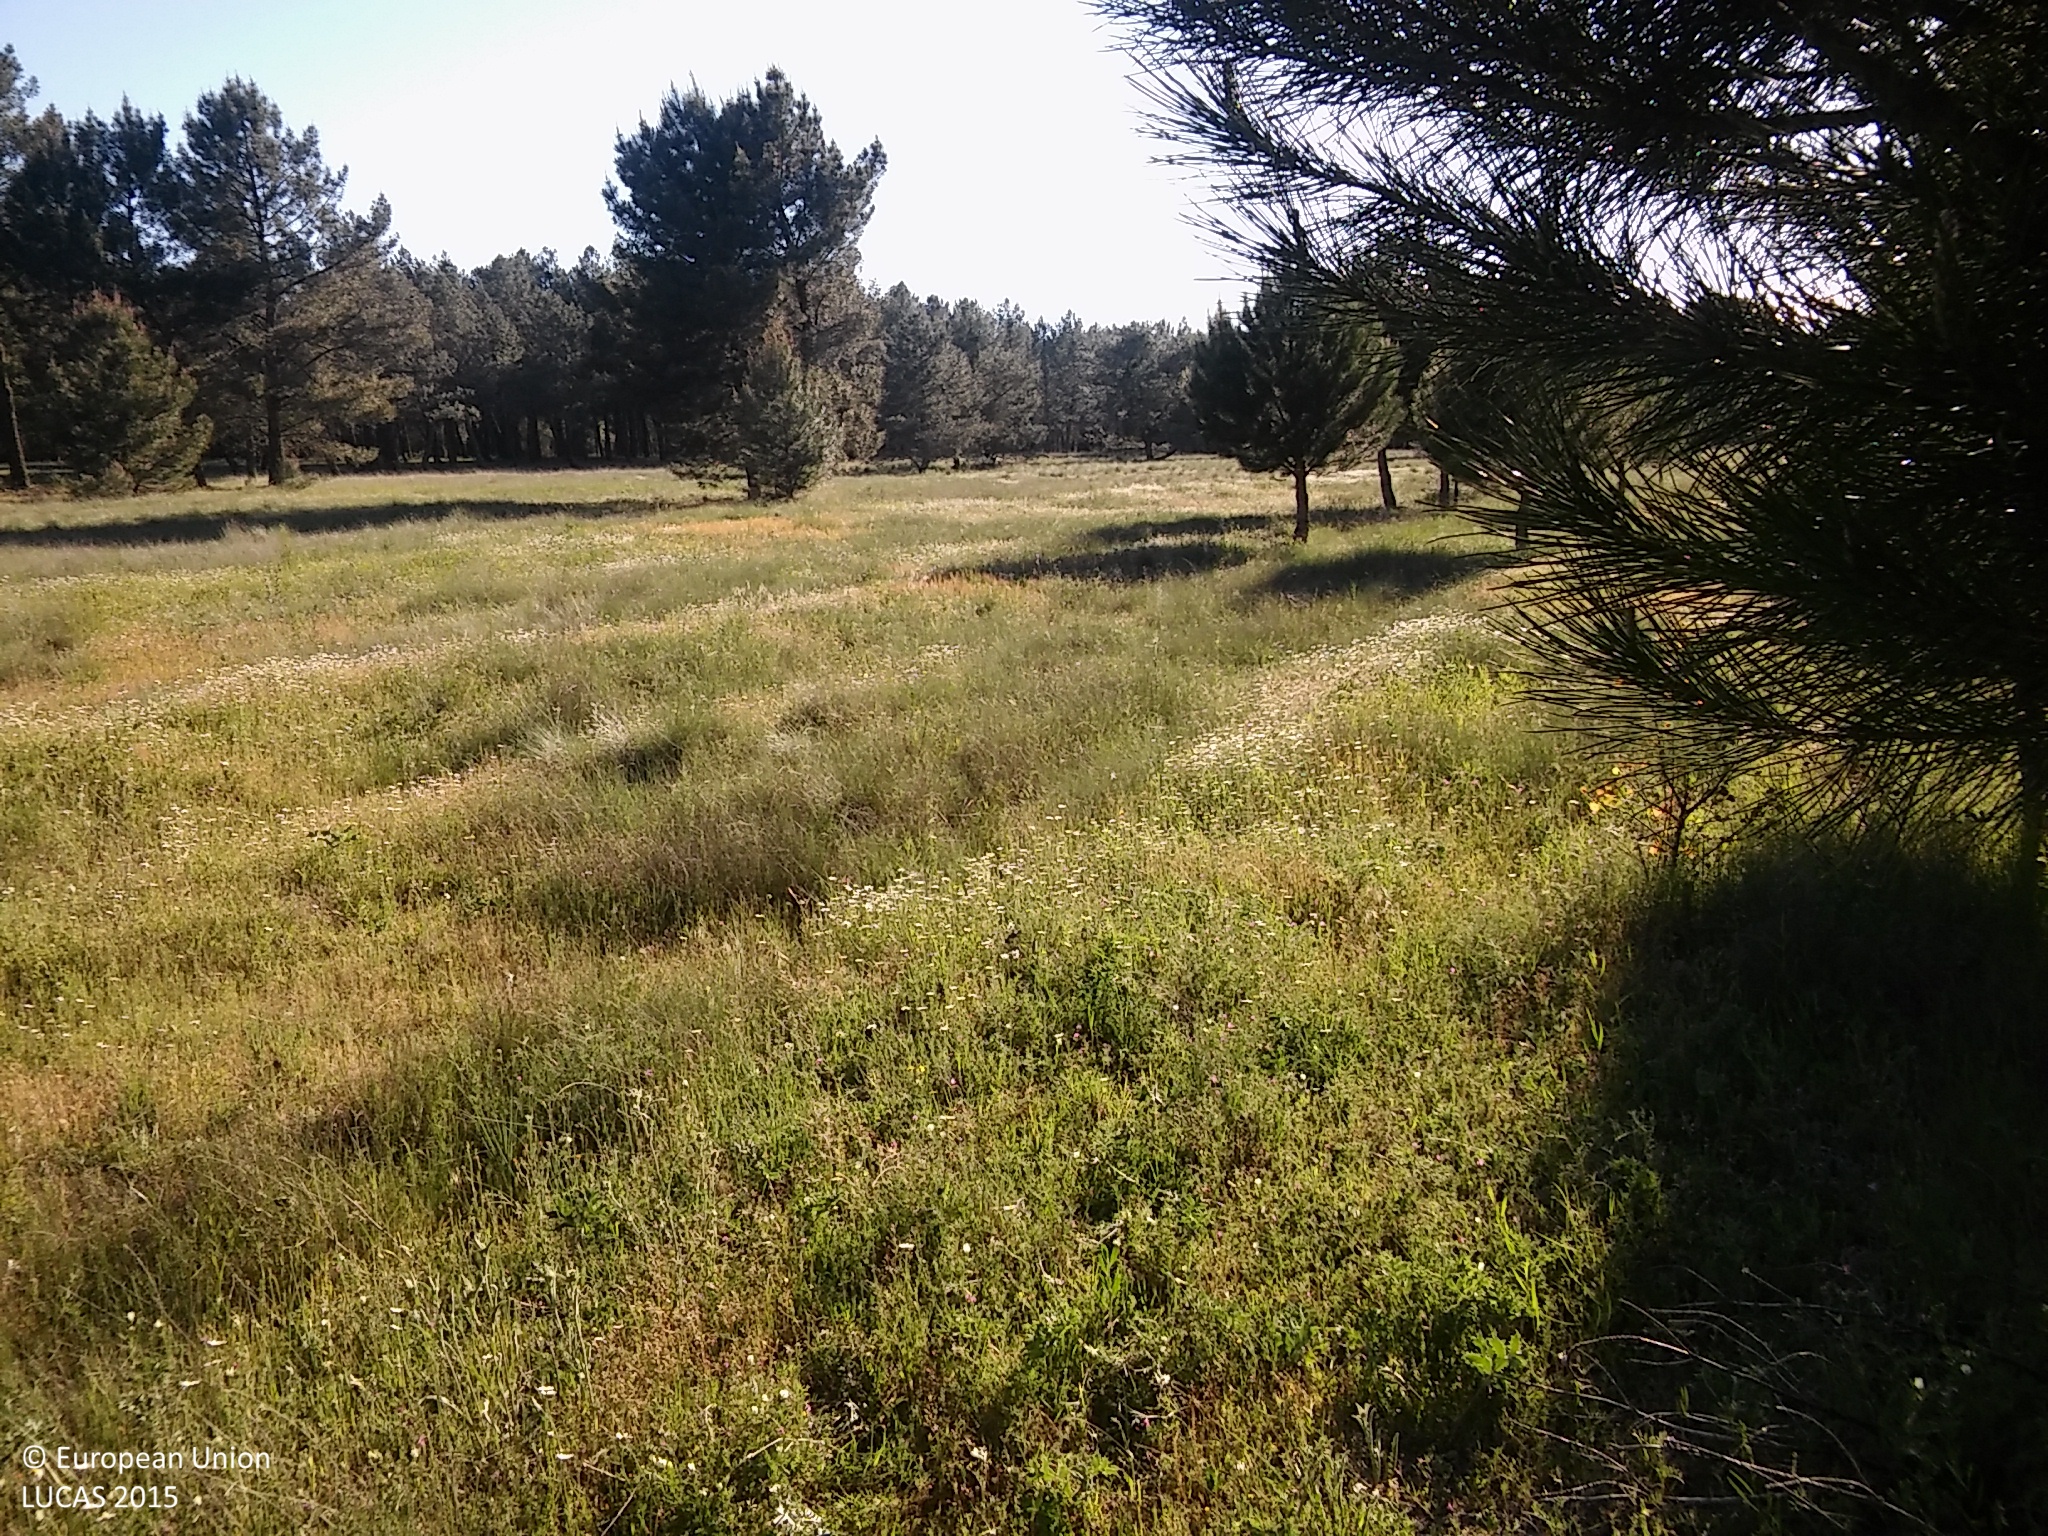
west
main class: Woodland
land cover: Pine dominated coniferous woodland
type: coniferous forest of the mediterranean region
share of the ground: 10 - 25 %
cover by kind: herbaceous plants 65 %, shrubs 25 %, coniferous forest trees 10 %
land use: Forestry
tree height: > 5 m
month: May
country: ES
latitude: 41.3256
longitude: -4.0201
